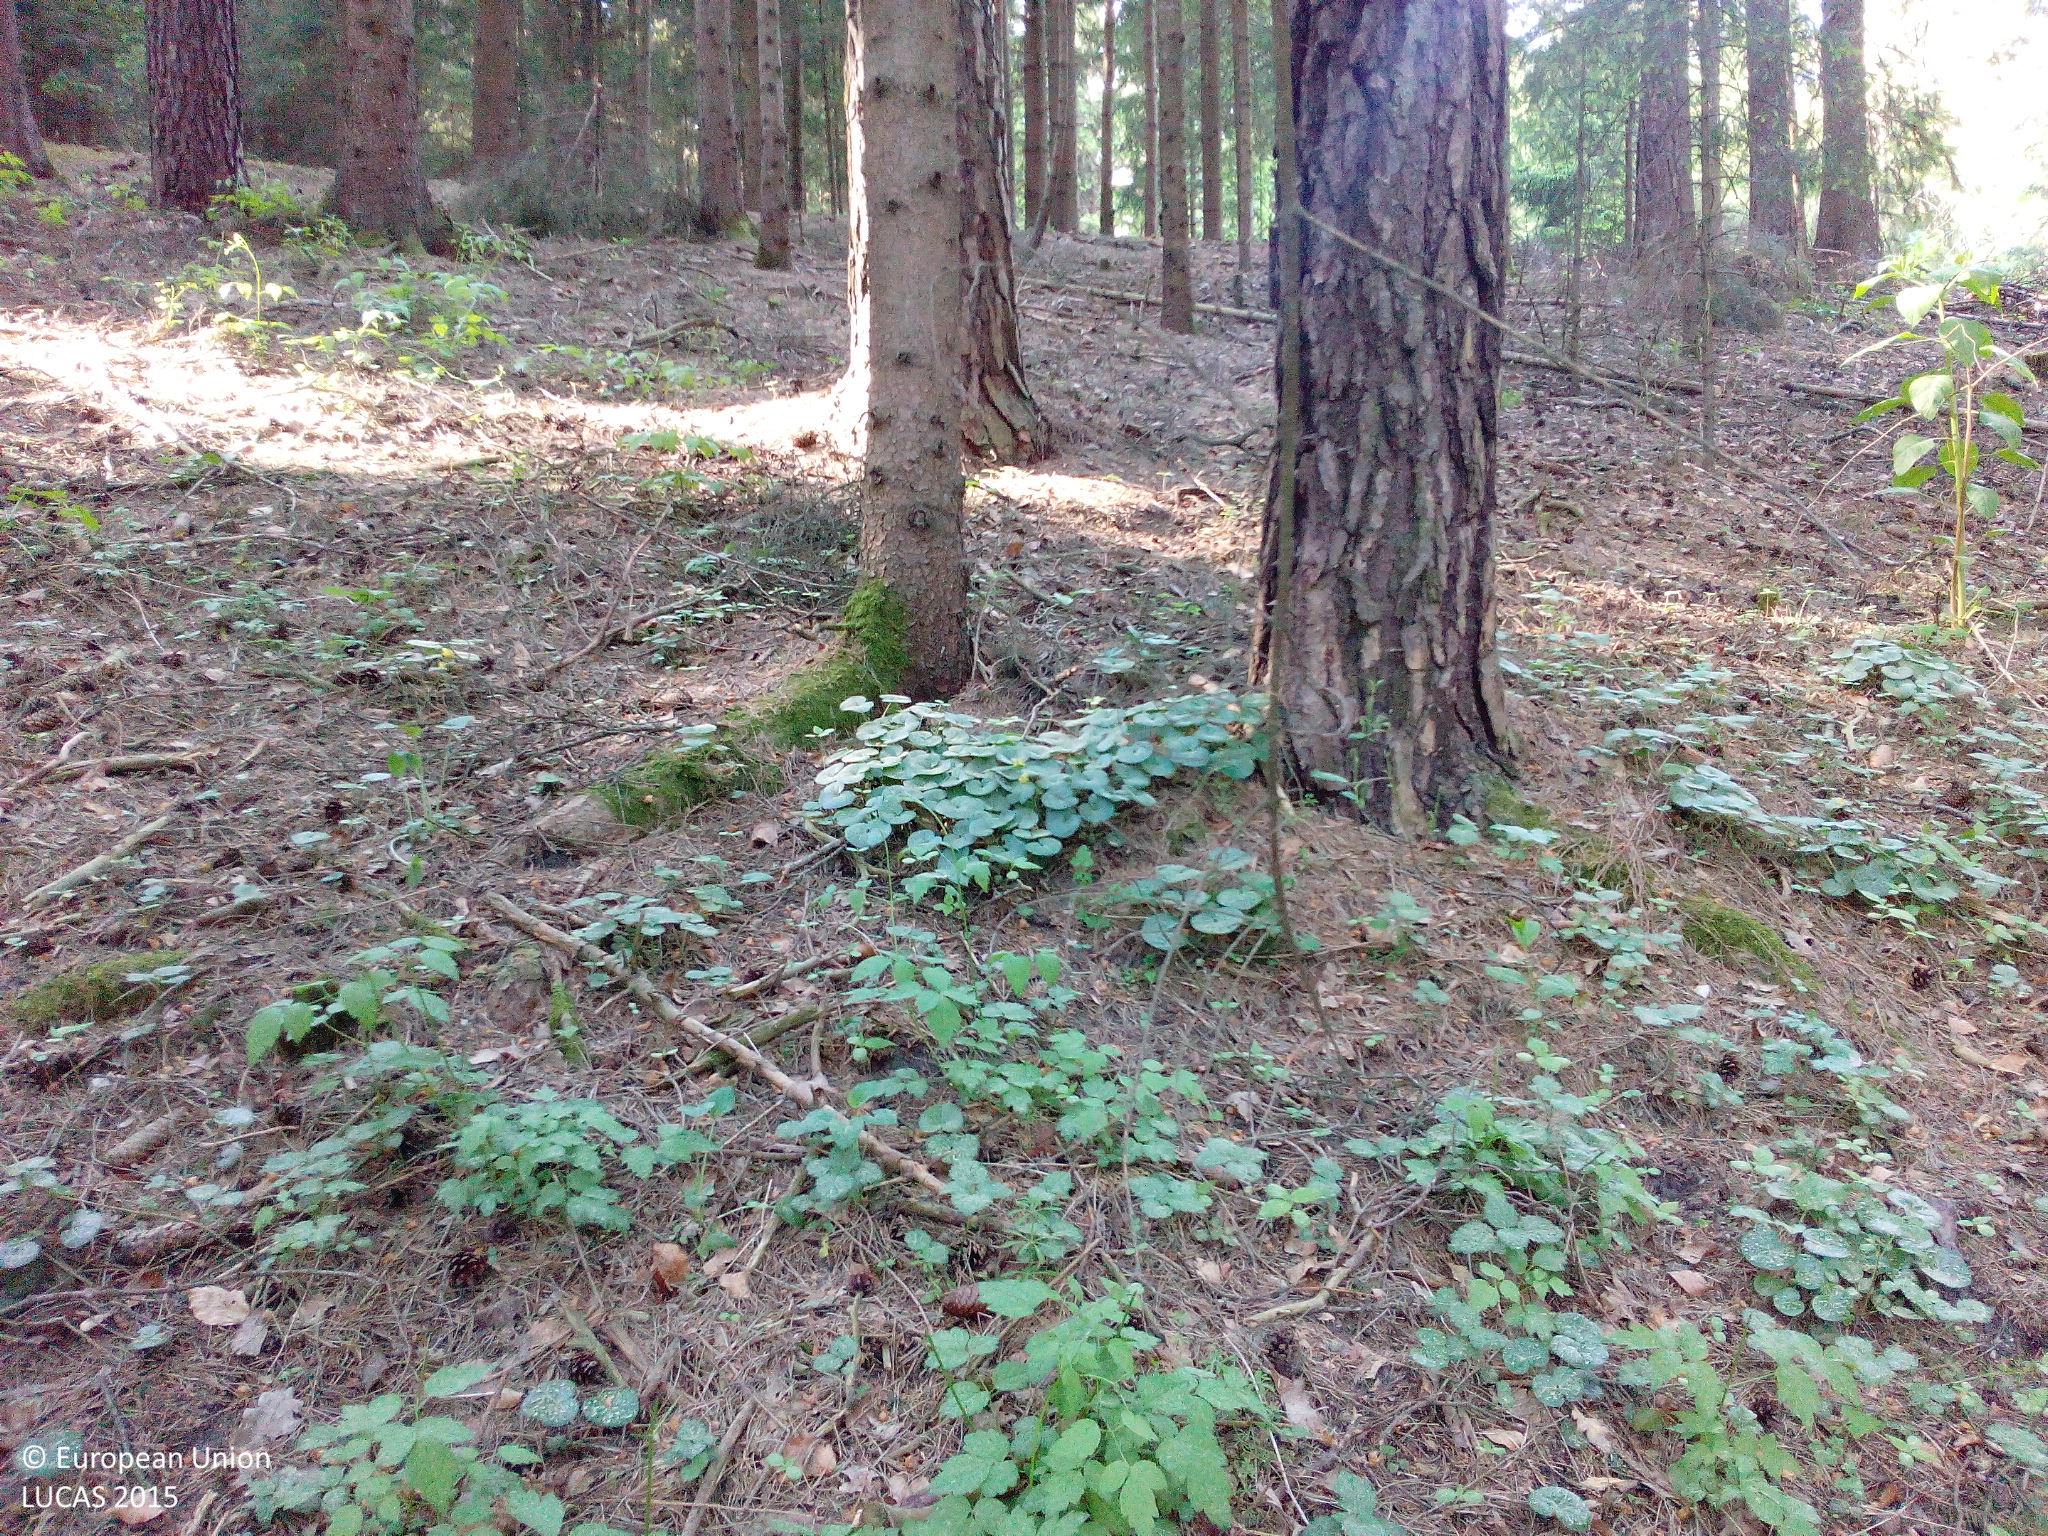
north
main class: Woodland
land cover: Other coniferous woodland
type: hemiboreal forest and nemoral coniferous forest and mixed broadleaved-coniferous forest
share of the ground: > 75 %
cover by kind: coniferous forest trees 85 %, unconsolidated bare surface 10 %, herbaceous plants 5 %
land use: Forestry
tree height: > 5 m
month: May
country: DE
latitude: 49.1851
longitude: 11.4949
